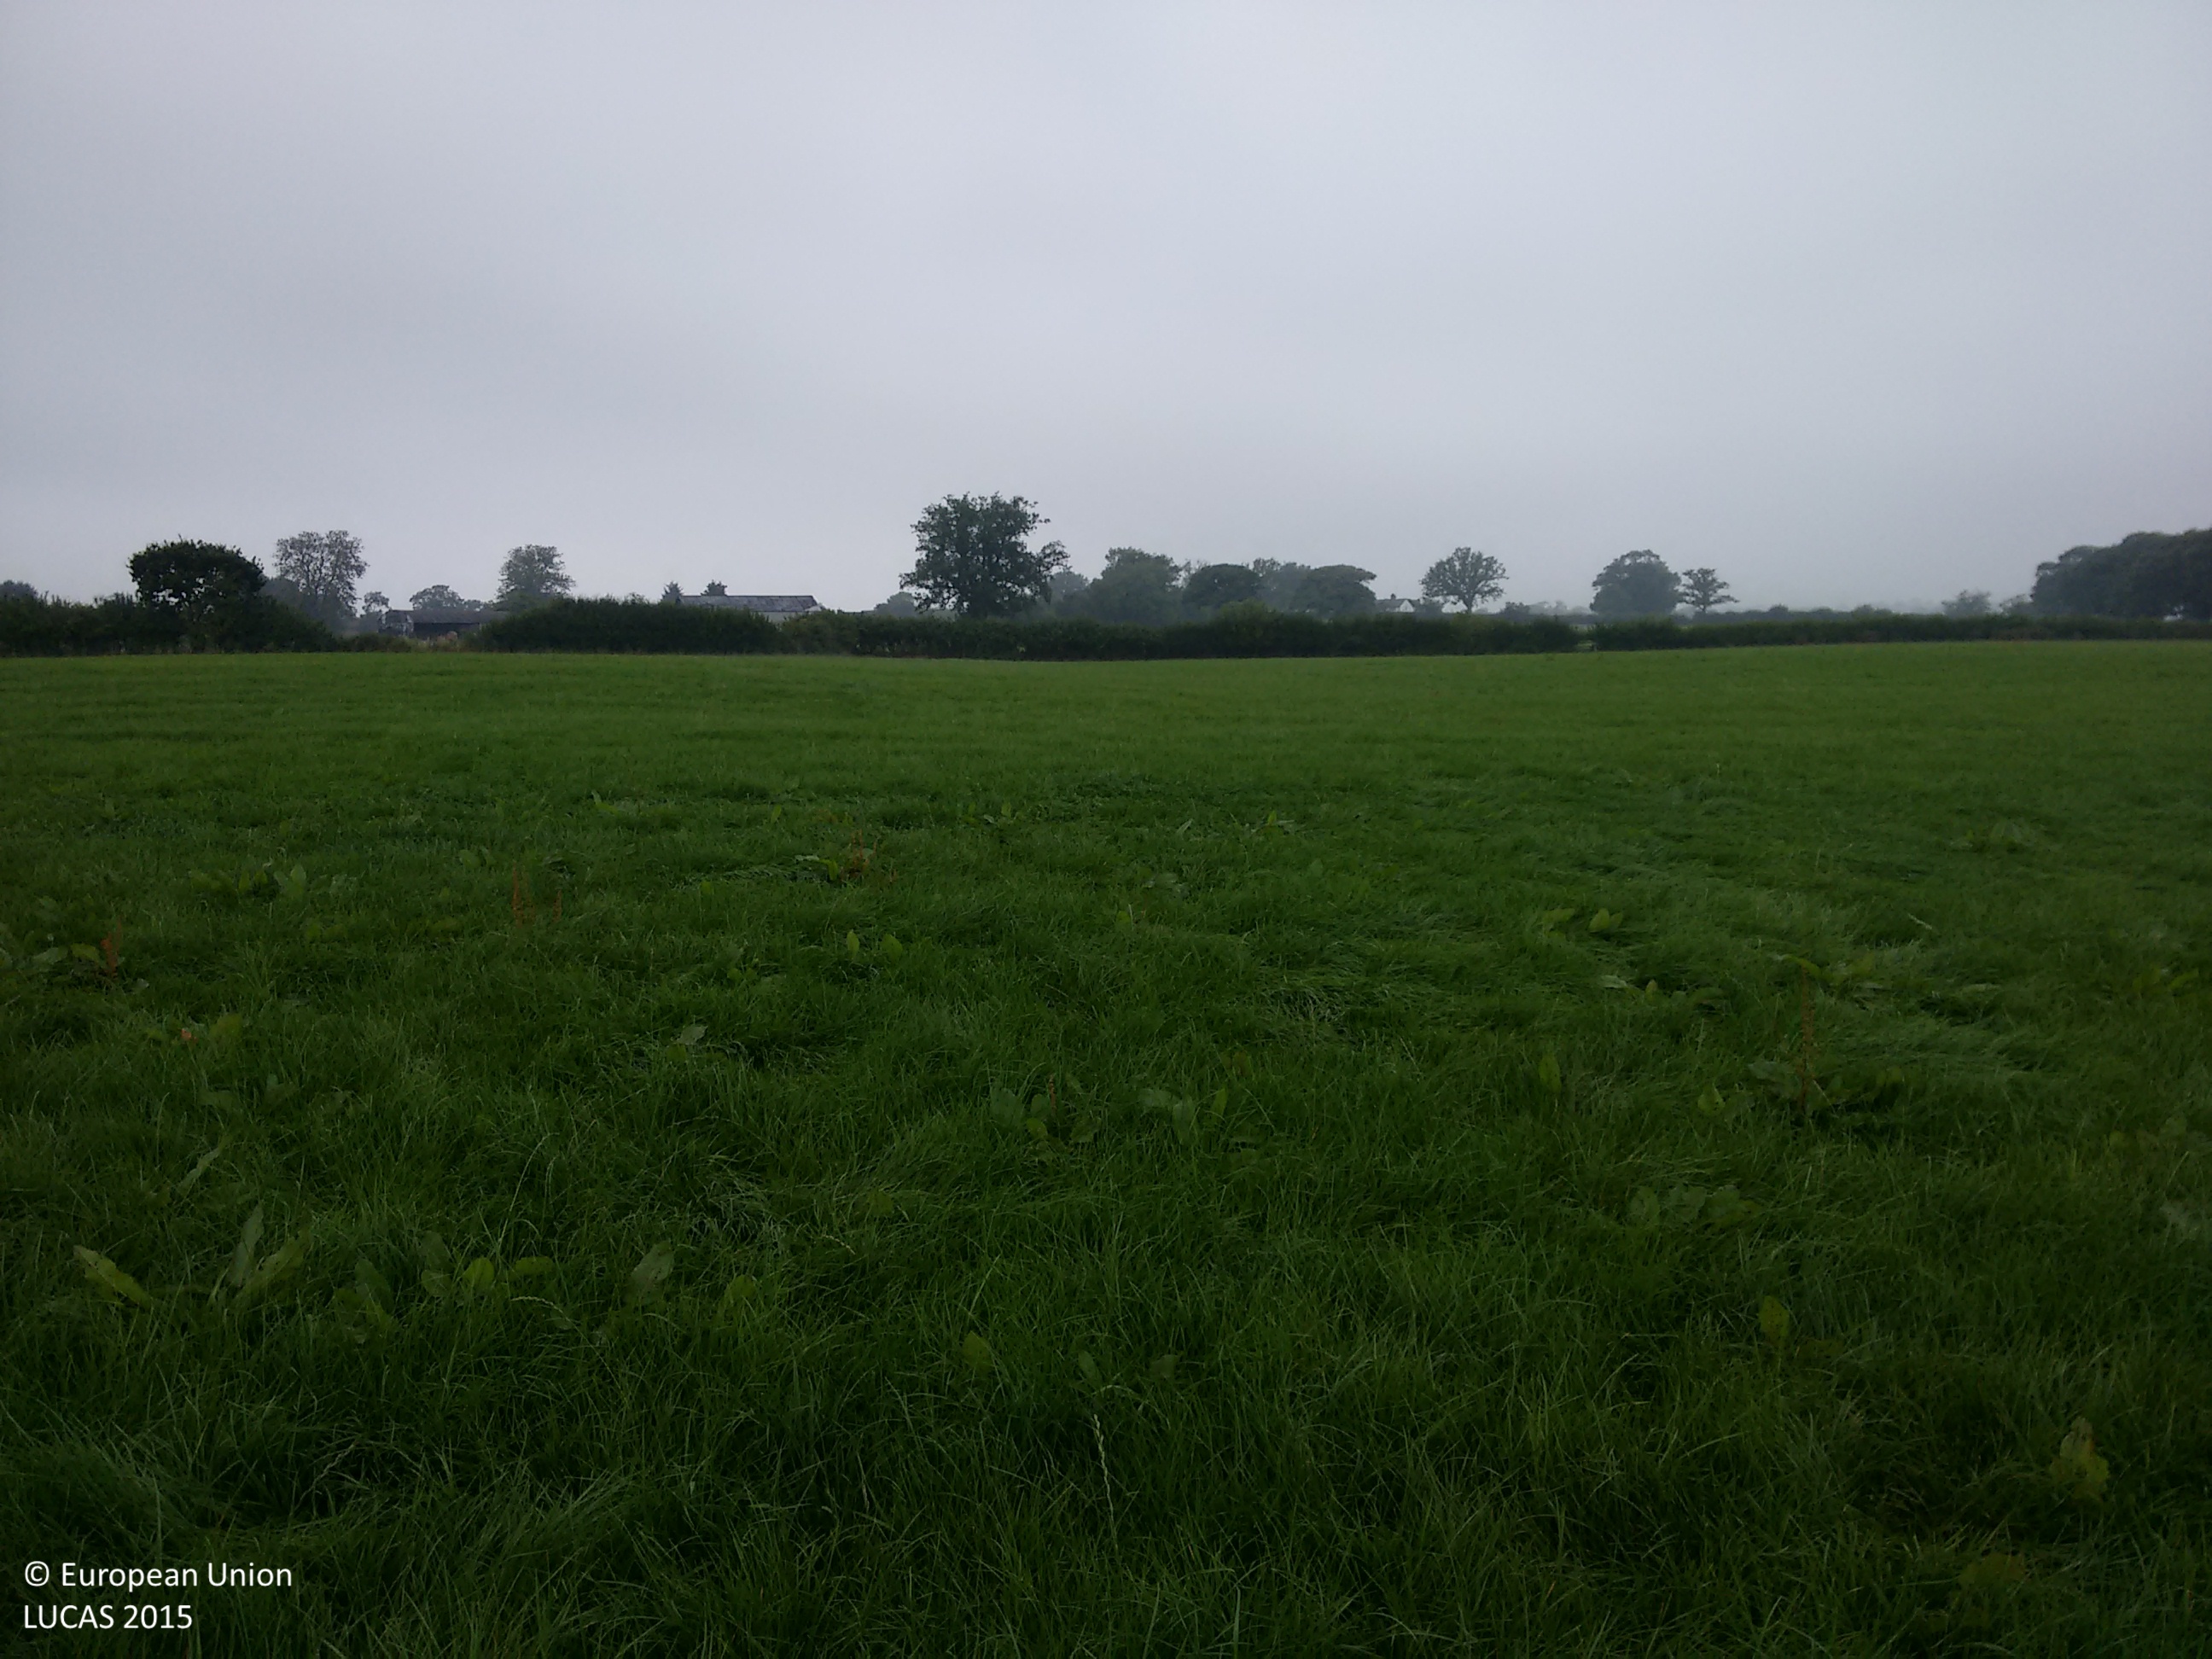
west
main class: Grassland
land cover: Grassland without tree/shrub cover
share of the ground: > 75 %
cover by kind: herbaceous plants 100 %
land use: Agriculture (excluding fallow land and kitchen gardens)
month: September
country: GB
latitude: 52.7013
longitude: -2.9637
